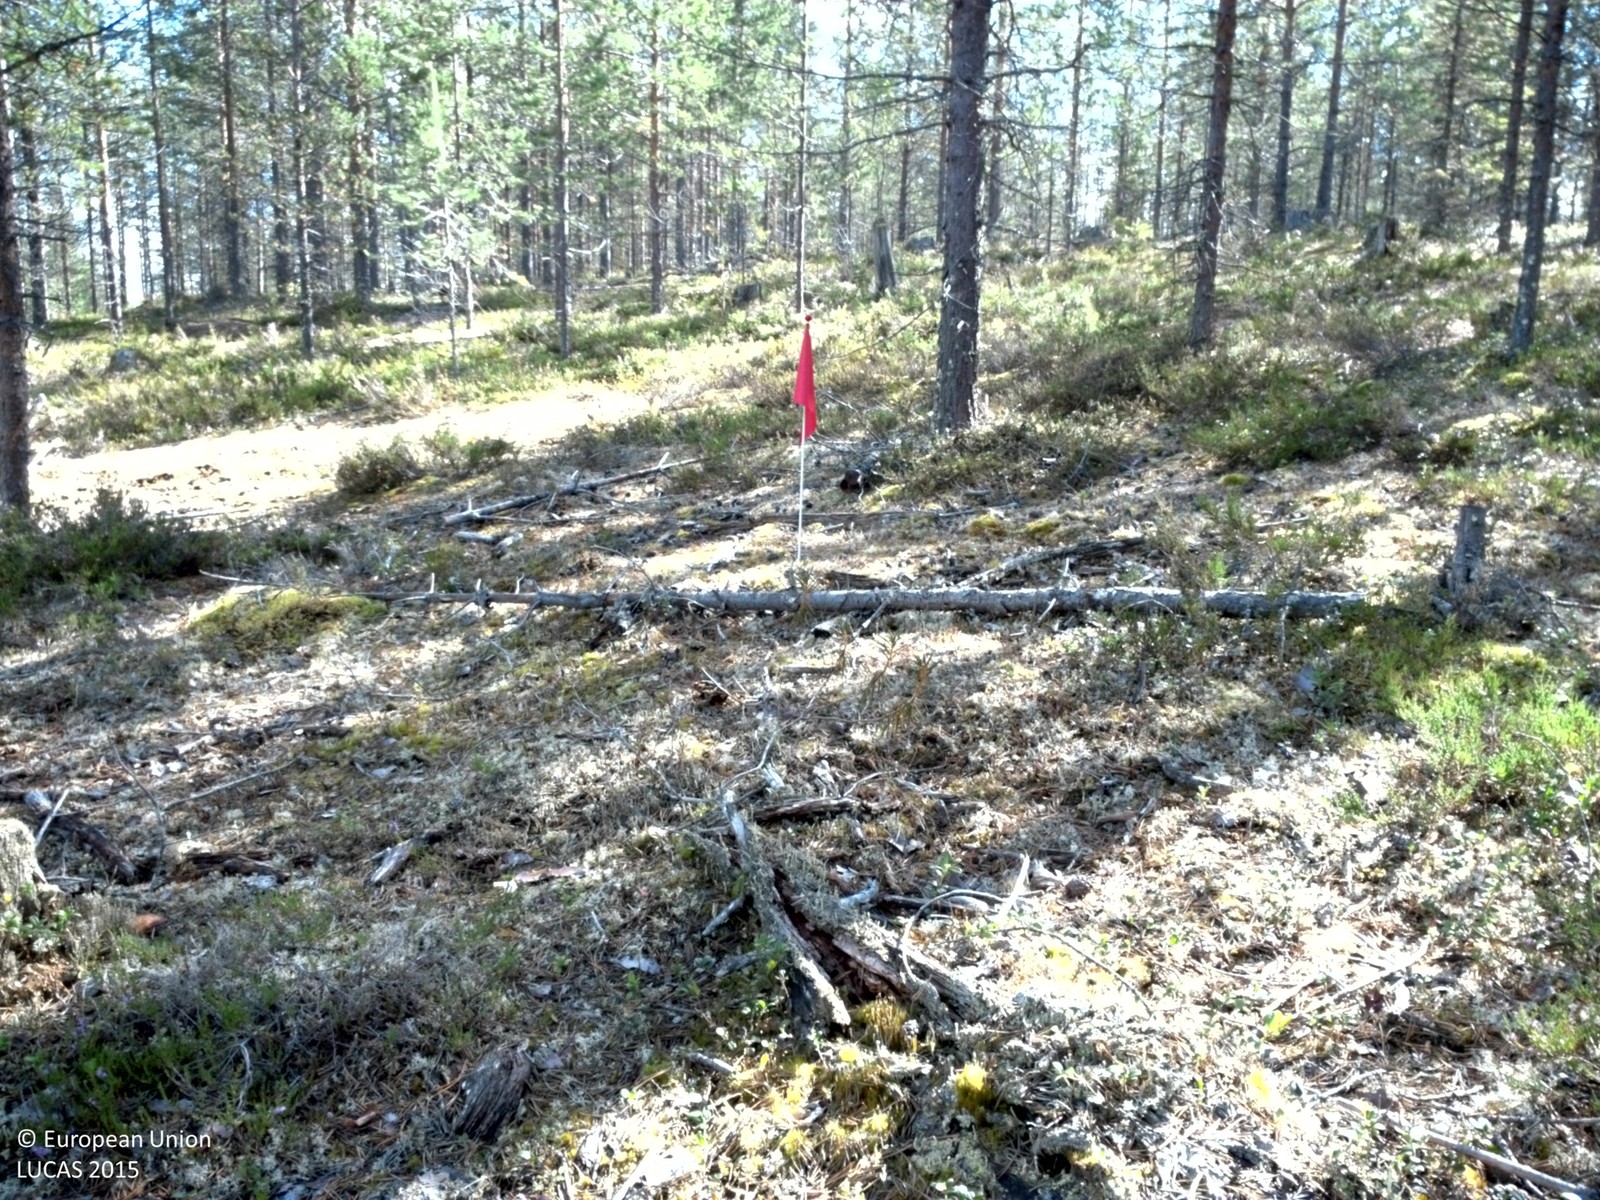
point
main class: Woodland
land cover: Pine dominated coniferous woodland
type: boreal forest
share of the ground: 25 - 50 %
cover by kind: shrubs 50 %, coniferous forest trees 35 %, lichens and mosses 15 %
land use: Forestry
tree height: > 5 m
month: August
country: SE
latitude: 66.1926
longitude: 22.2950
